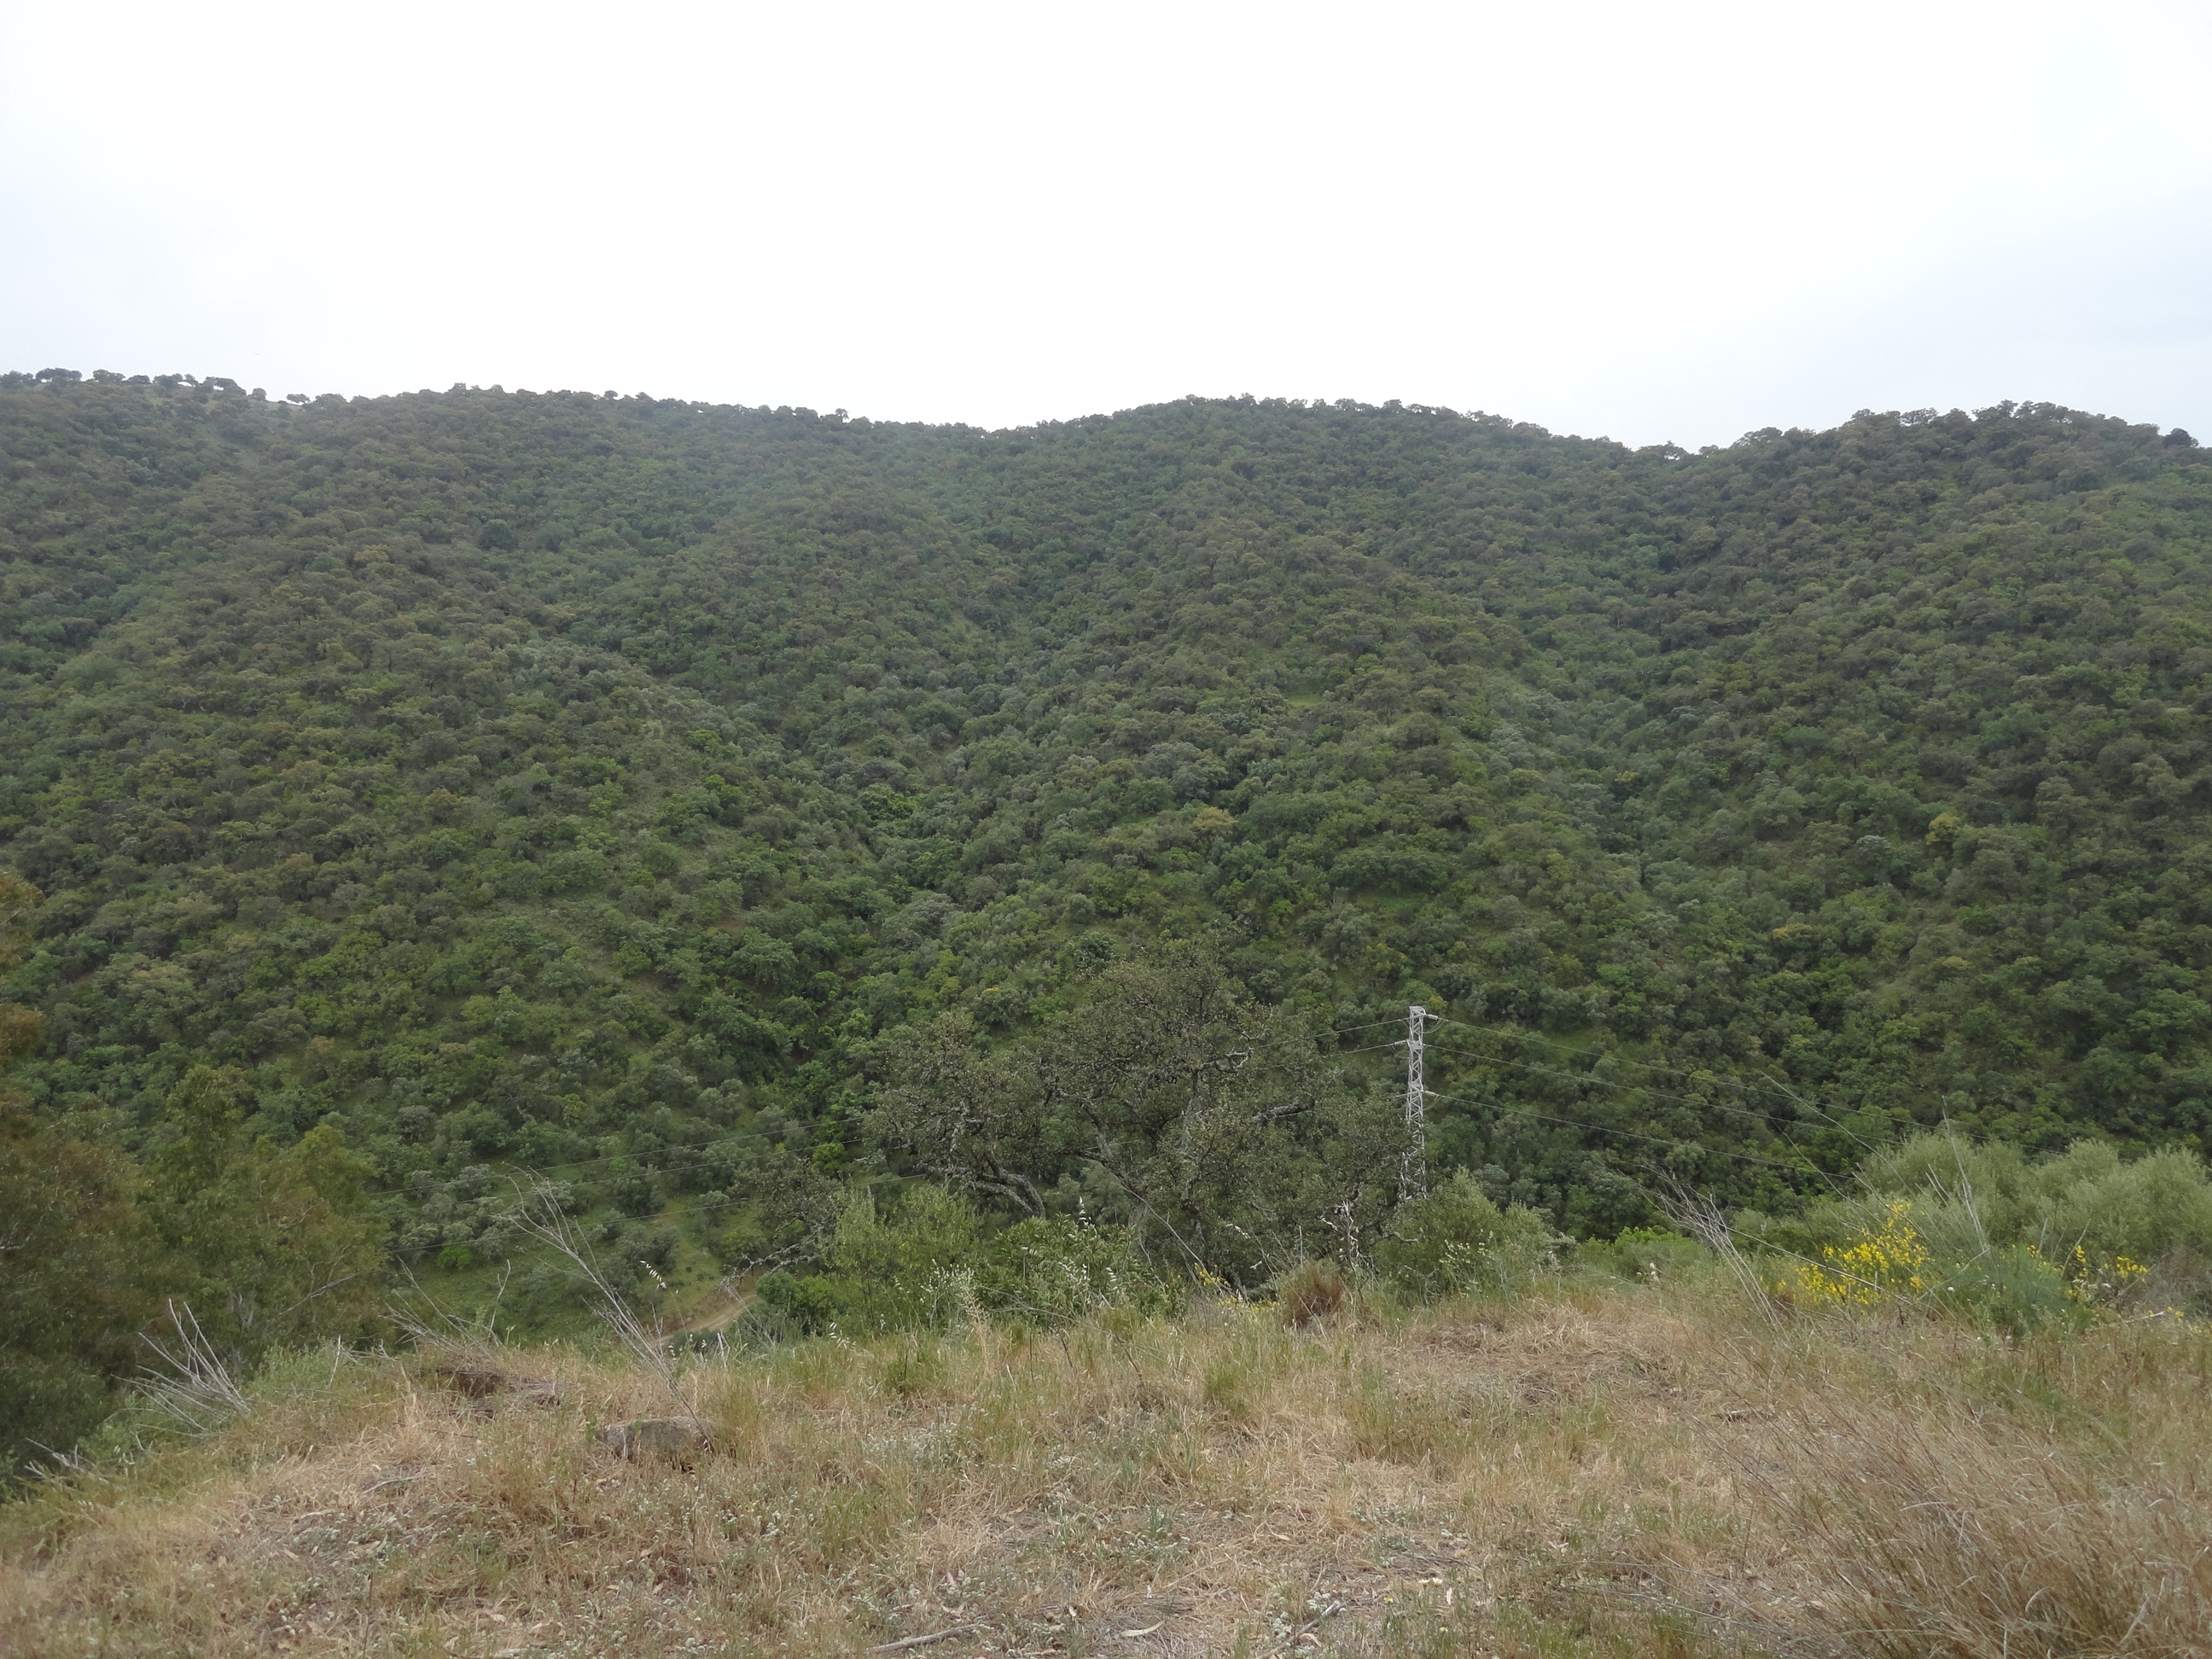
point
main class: Woodland
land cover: Broadleaved woodland
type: broadleaved evergreen forest
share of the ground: > 75 %
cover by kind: broadleaved forest trees 85 %, shrubs 5 %, herbaceous plants 5 %, unconsolidated bare surface 5 %
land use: Semi-natural and natural areas not in use
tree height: > 5 m
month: April
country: ES
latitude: 37.8981
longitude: -5.2025
